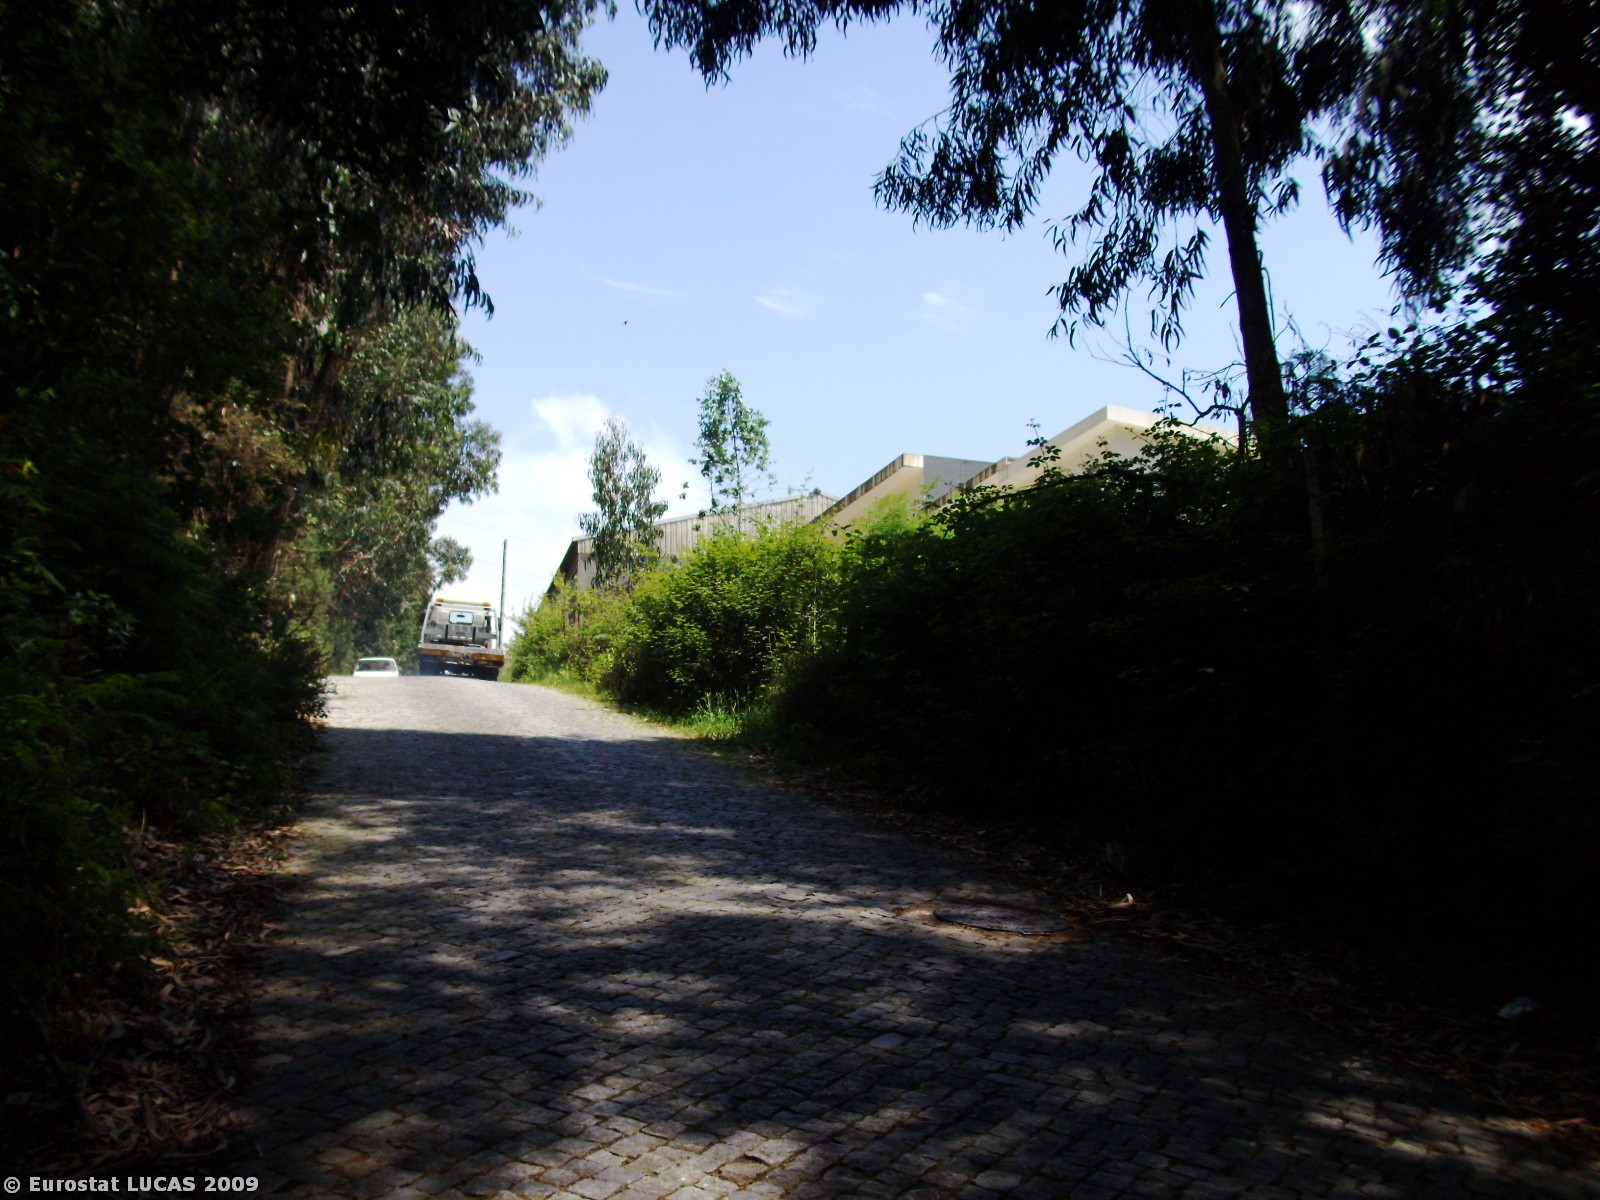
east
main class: Woodland
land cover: Broadleaved woodland
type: plantations and self-sown exotic forest
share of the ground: > 75 %
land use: Forestry
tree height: > 5 m
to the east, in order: Broadleaved woodland; Artificial constructions in urban areas
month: May
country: PT
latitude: 41.0816
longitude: -8.5888
